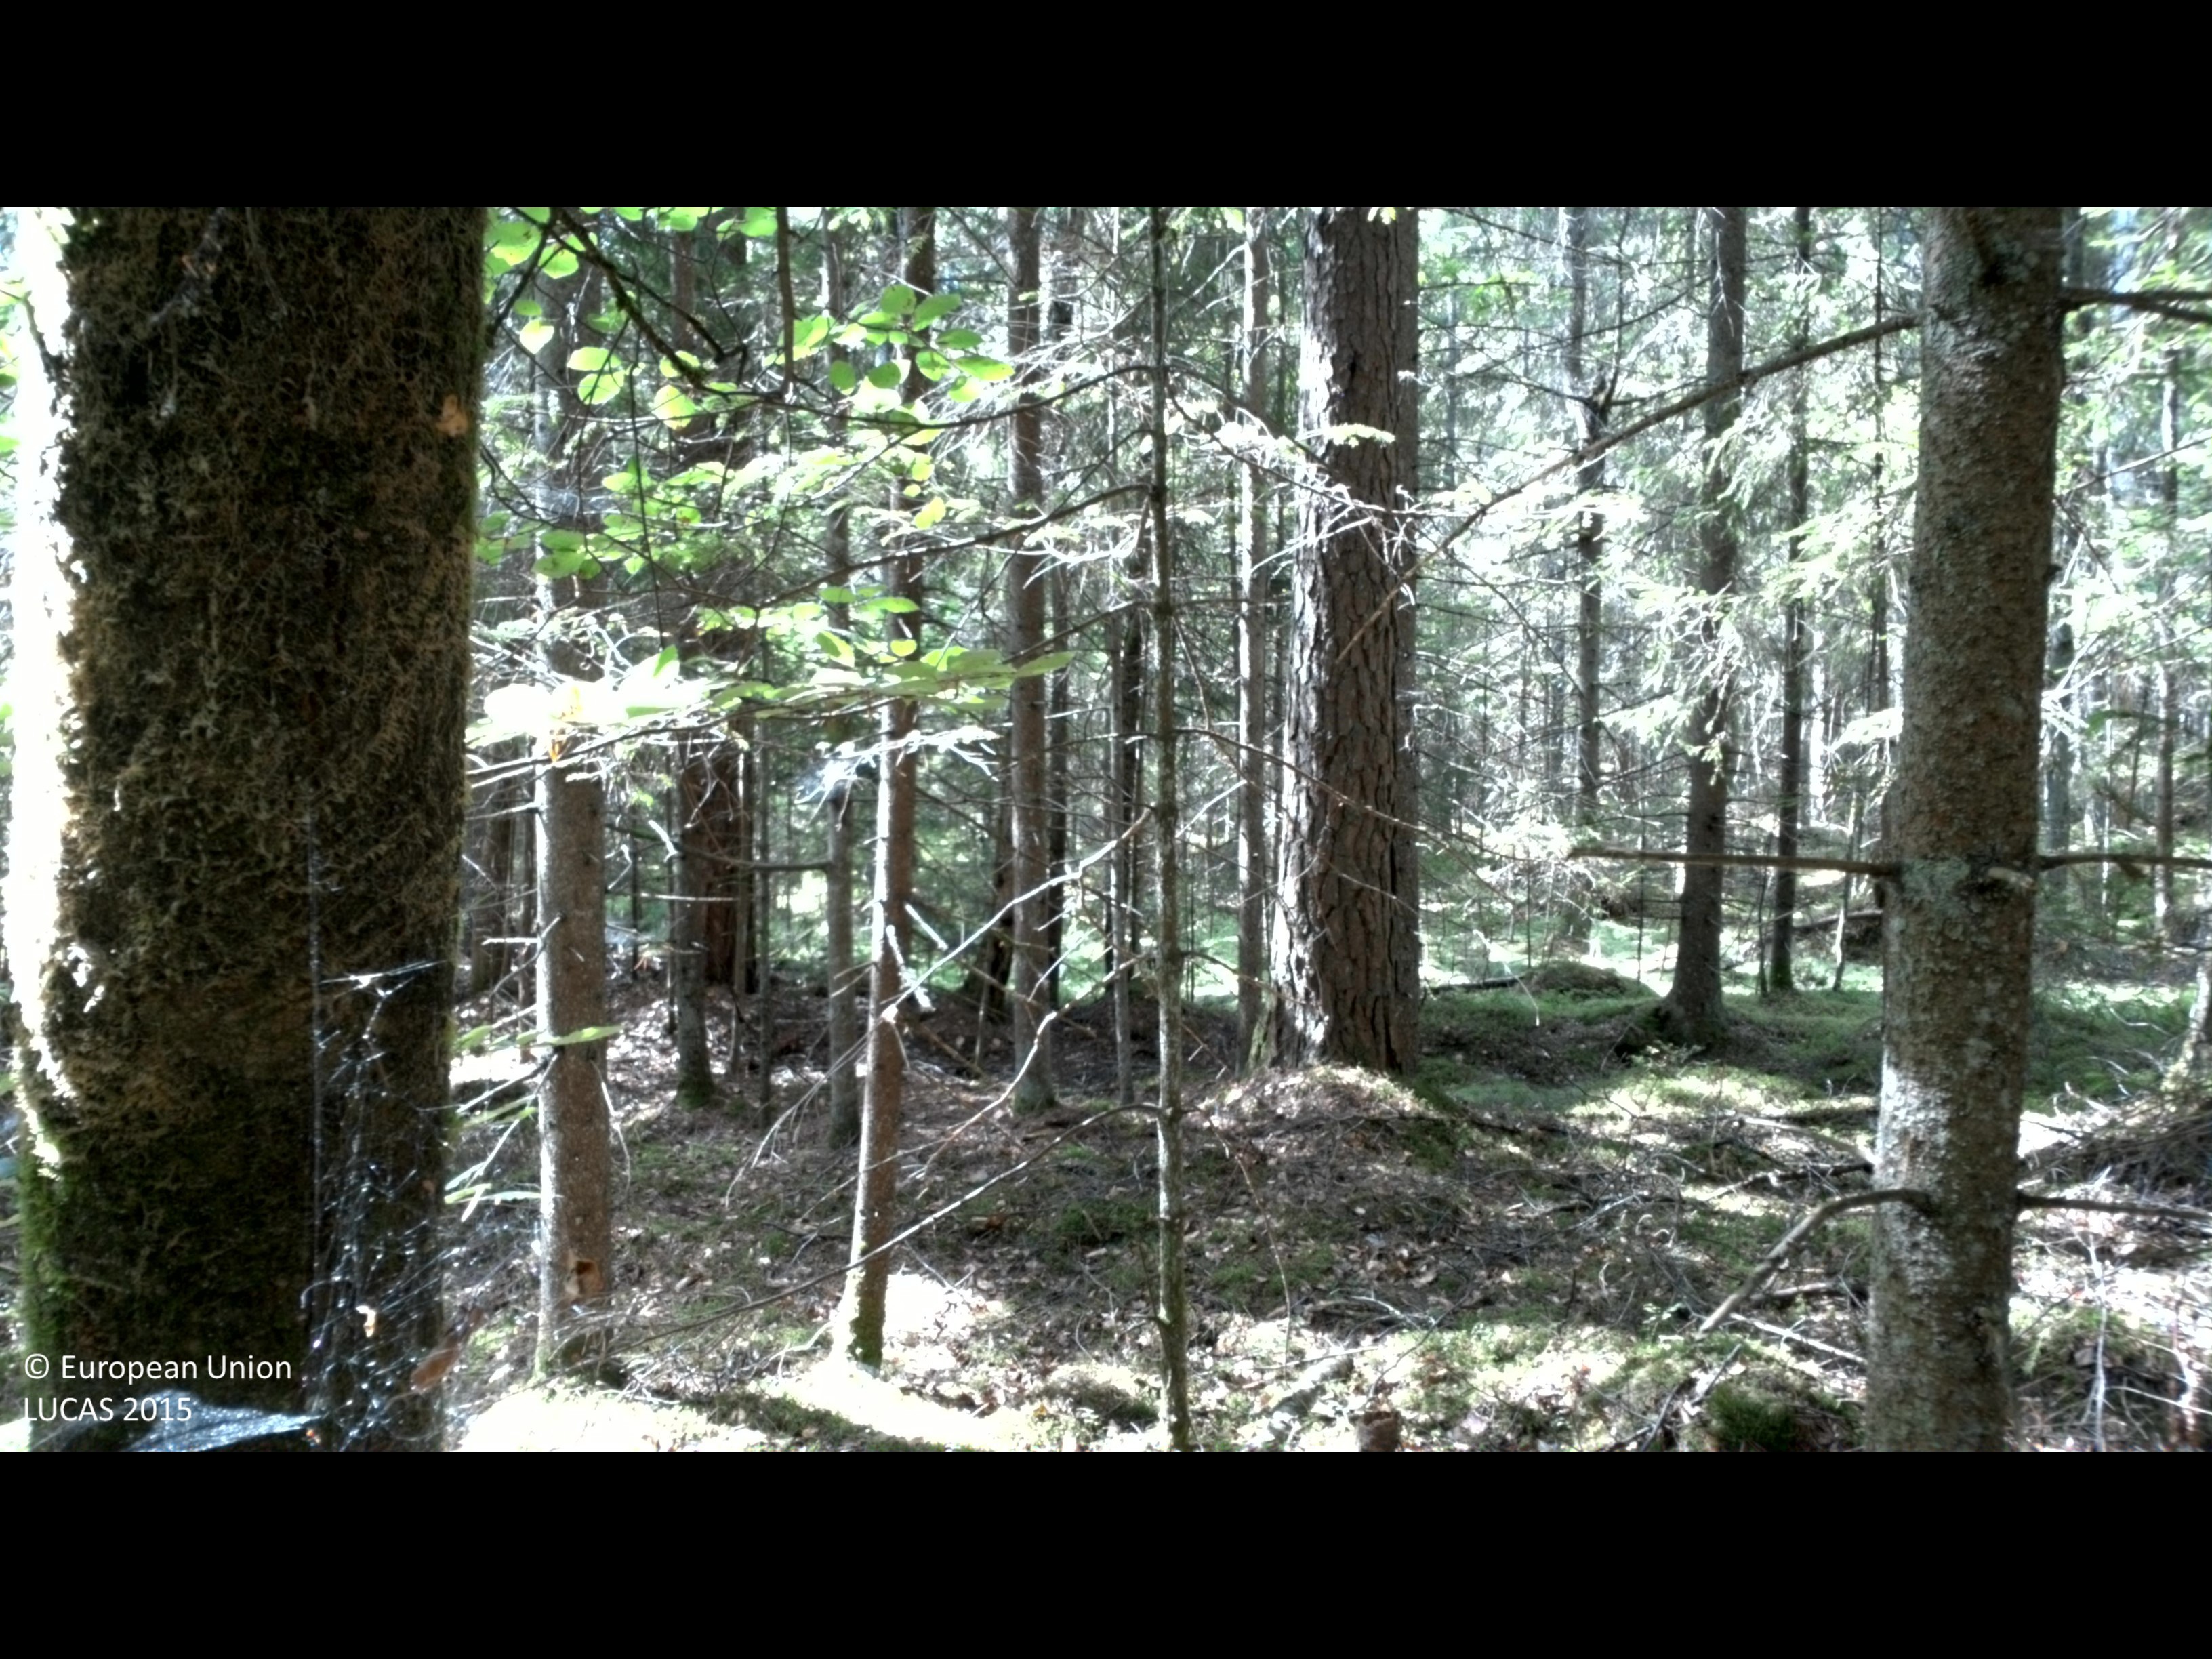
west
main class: Woodland
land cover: Spruce dominated coniferous woodland
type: boreal forest
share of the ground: > 75 %
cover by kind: coniferous forest trees 70 %, broadleaved forest trees 15 %, shrubs 5 %, herbaceous plants 5 %, lichens and mosses 5 %
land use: Forestry
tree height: > 5 m
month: August
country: SE
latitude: 56.2784
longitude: 14.7951
